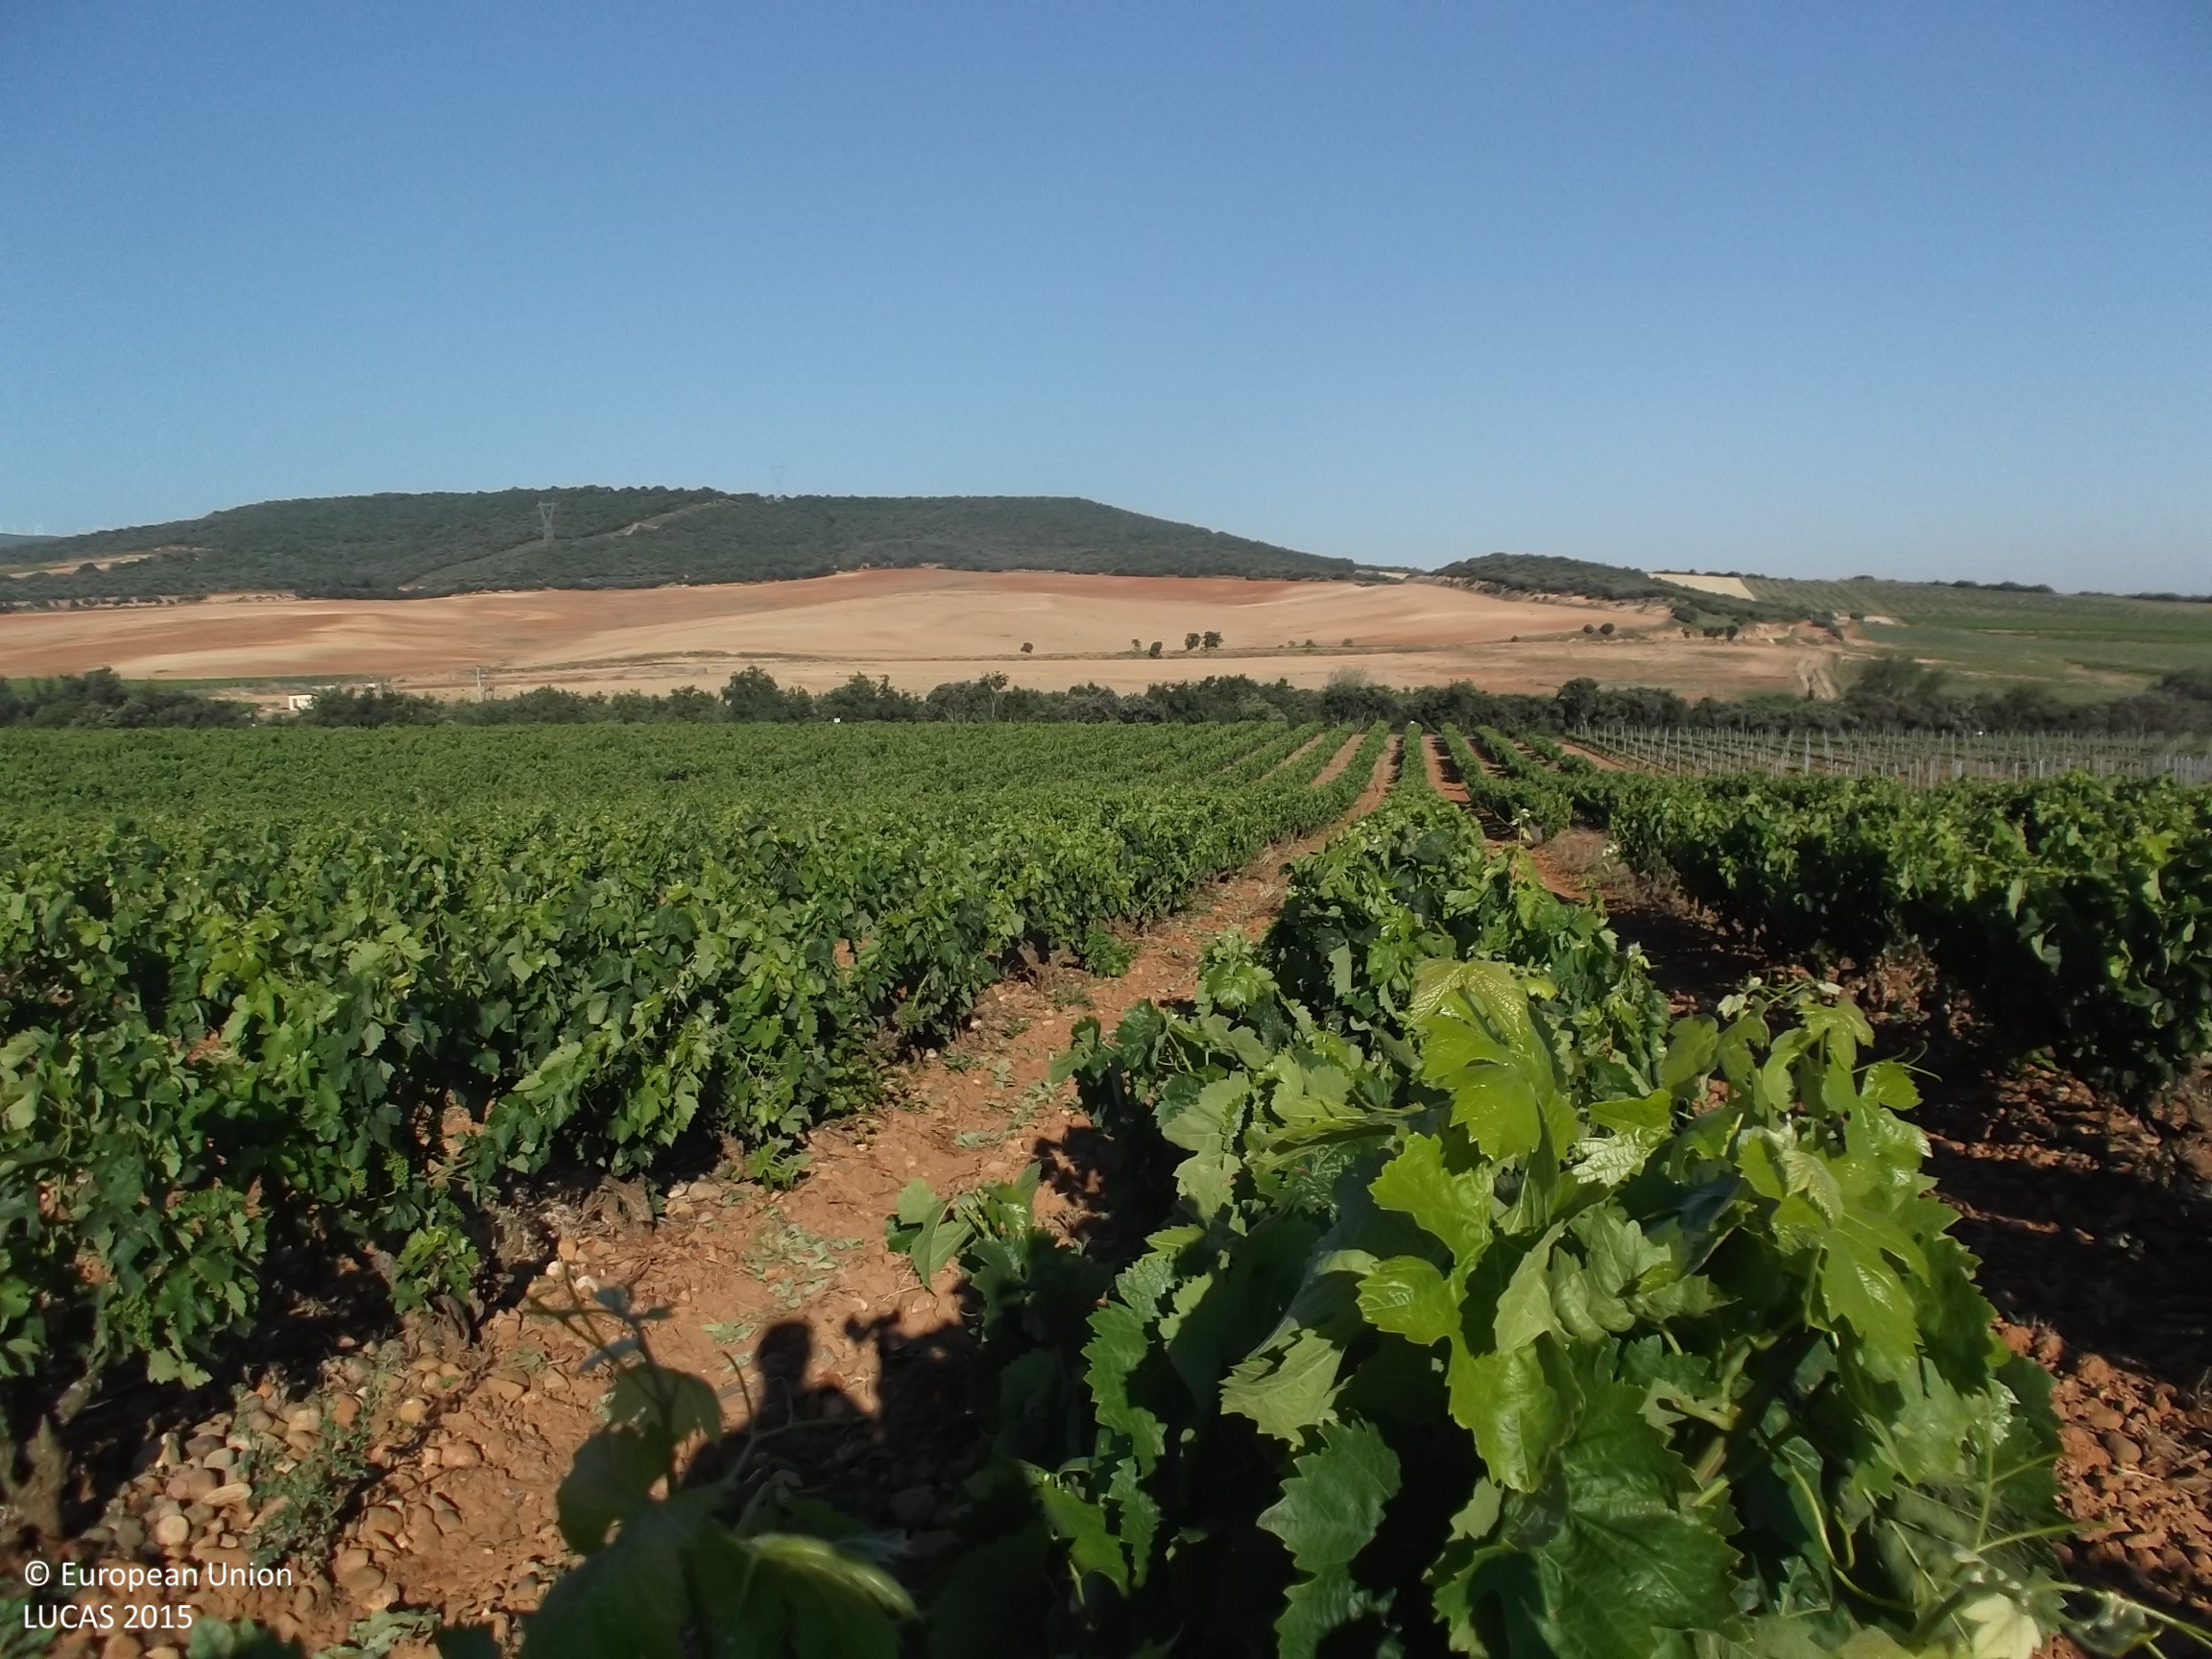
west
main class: Cropland
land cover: Vineyards
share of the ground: 10 - 25 %
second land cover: Other bare soil
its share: > 75 %
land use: Agriculture (excluding fallow land and kitchen gardens)
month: June
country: ES
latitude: 42.3225
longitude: -2.1377
